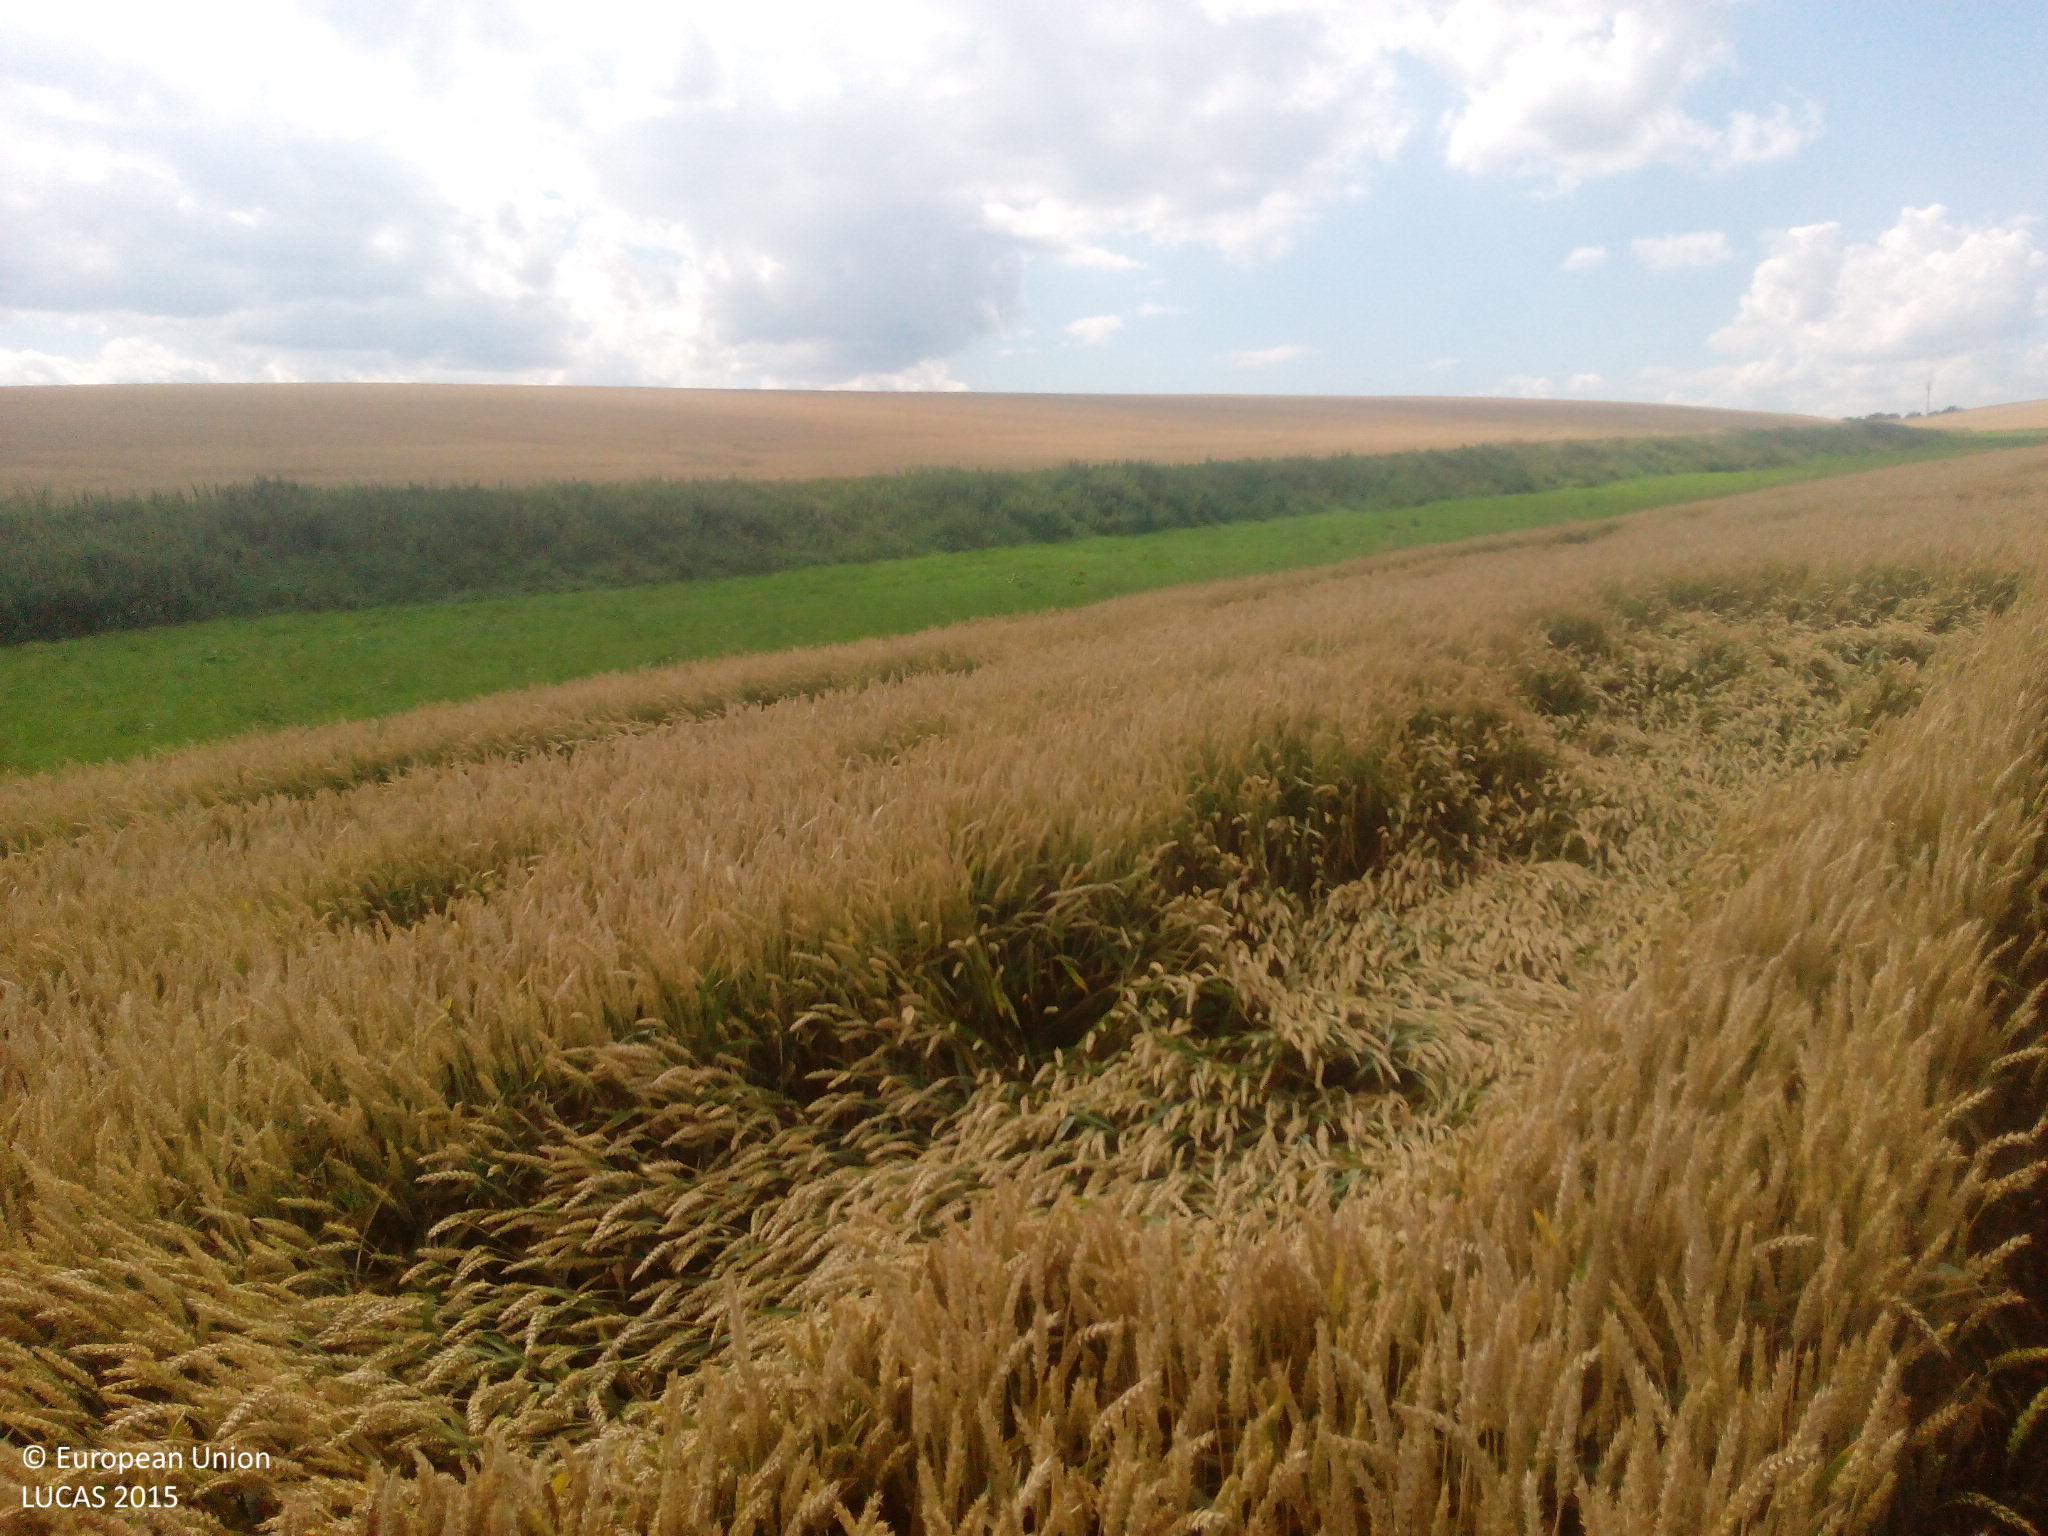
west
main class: Cropland
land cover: Common wheat
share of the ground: > 75 %
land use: Agriculture (excluding fallow land and kitchen gardens)
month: July
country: DE
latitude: 51.1588
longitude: 13.4177
